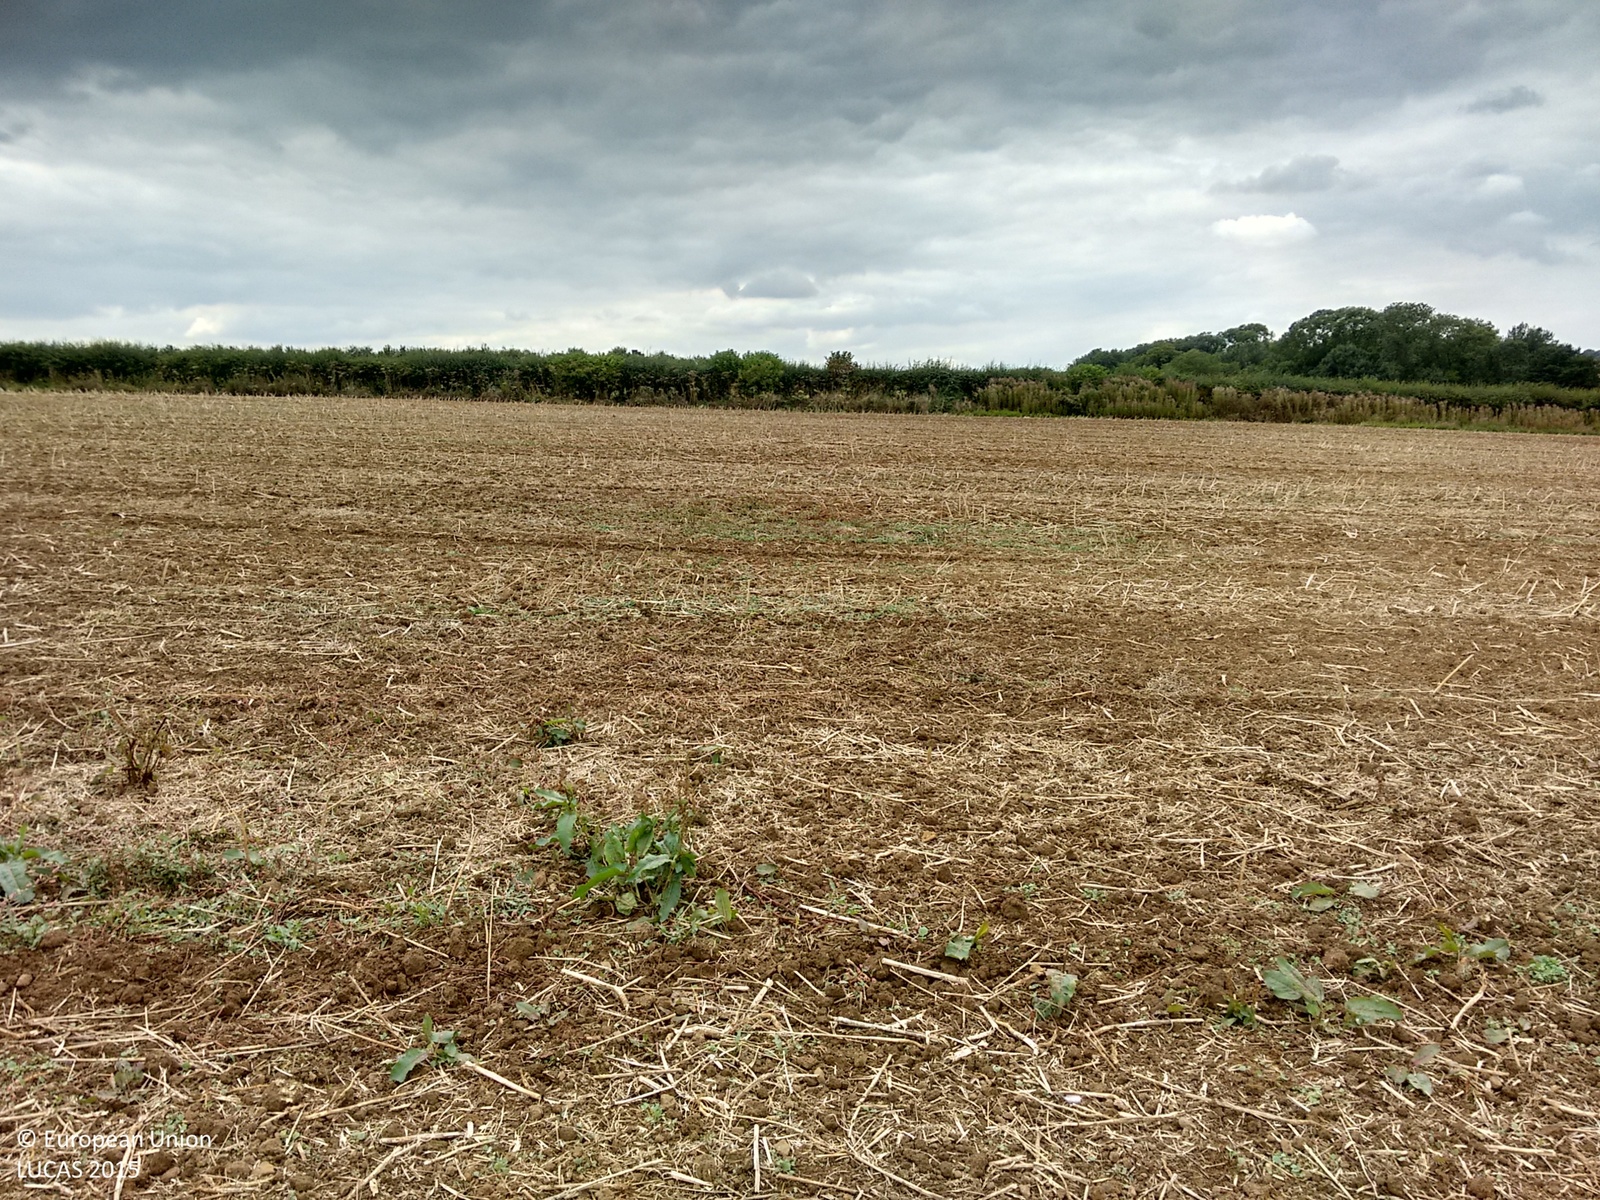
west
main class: Cropland
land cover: Rape and turnip rape
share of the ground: < 10 %
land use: Agriculture (excluding fallow land and kitchen gardens)
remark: Harvested field
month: August
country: GB
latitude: 52.3625
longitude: -0.7167
